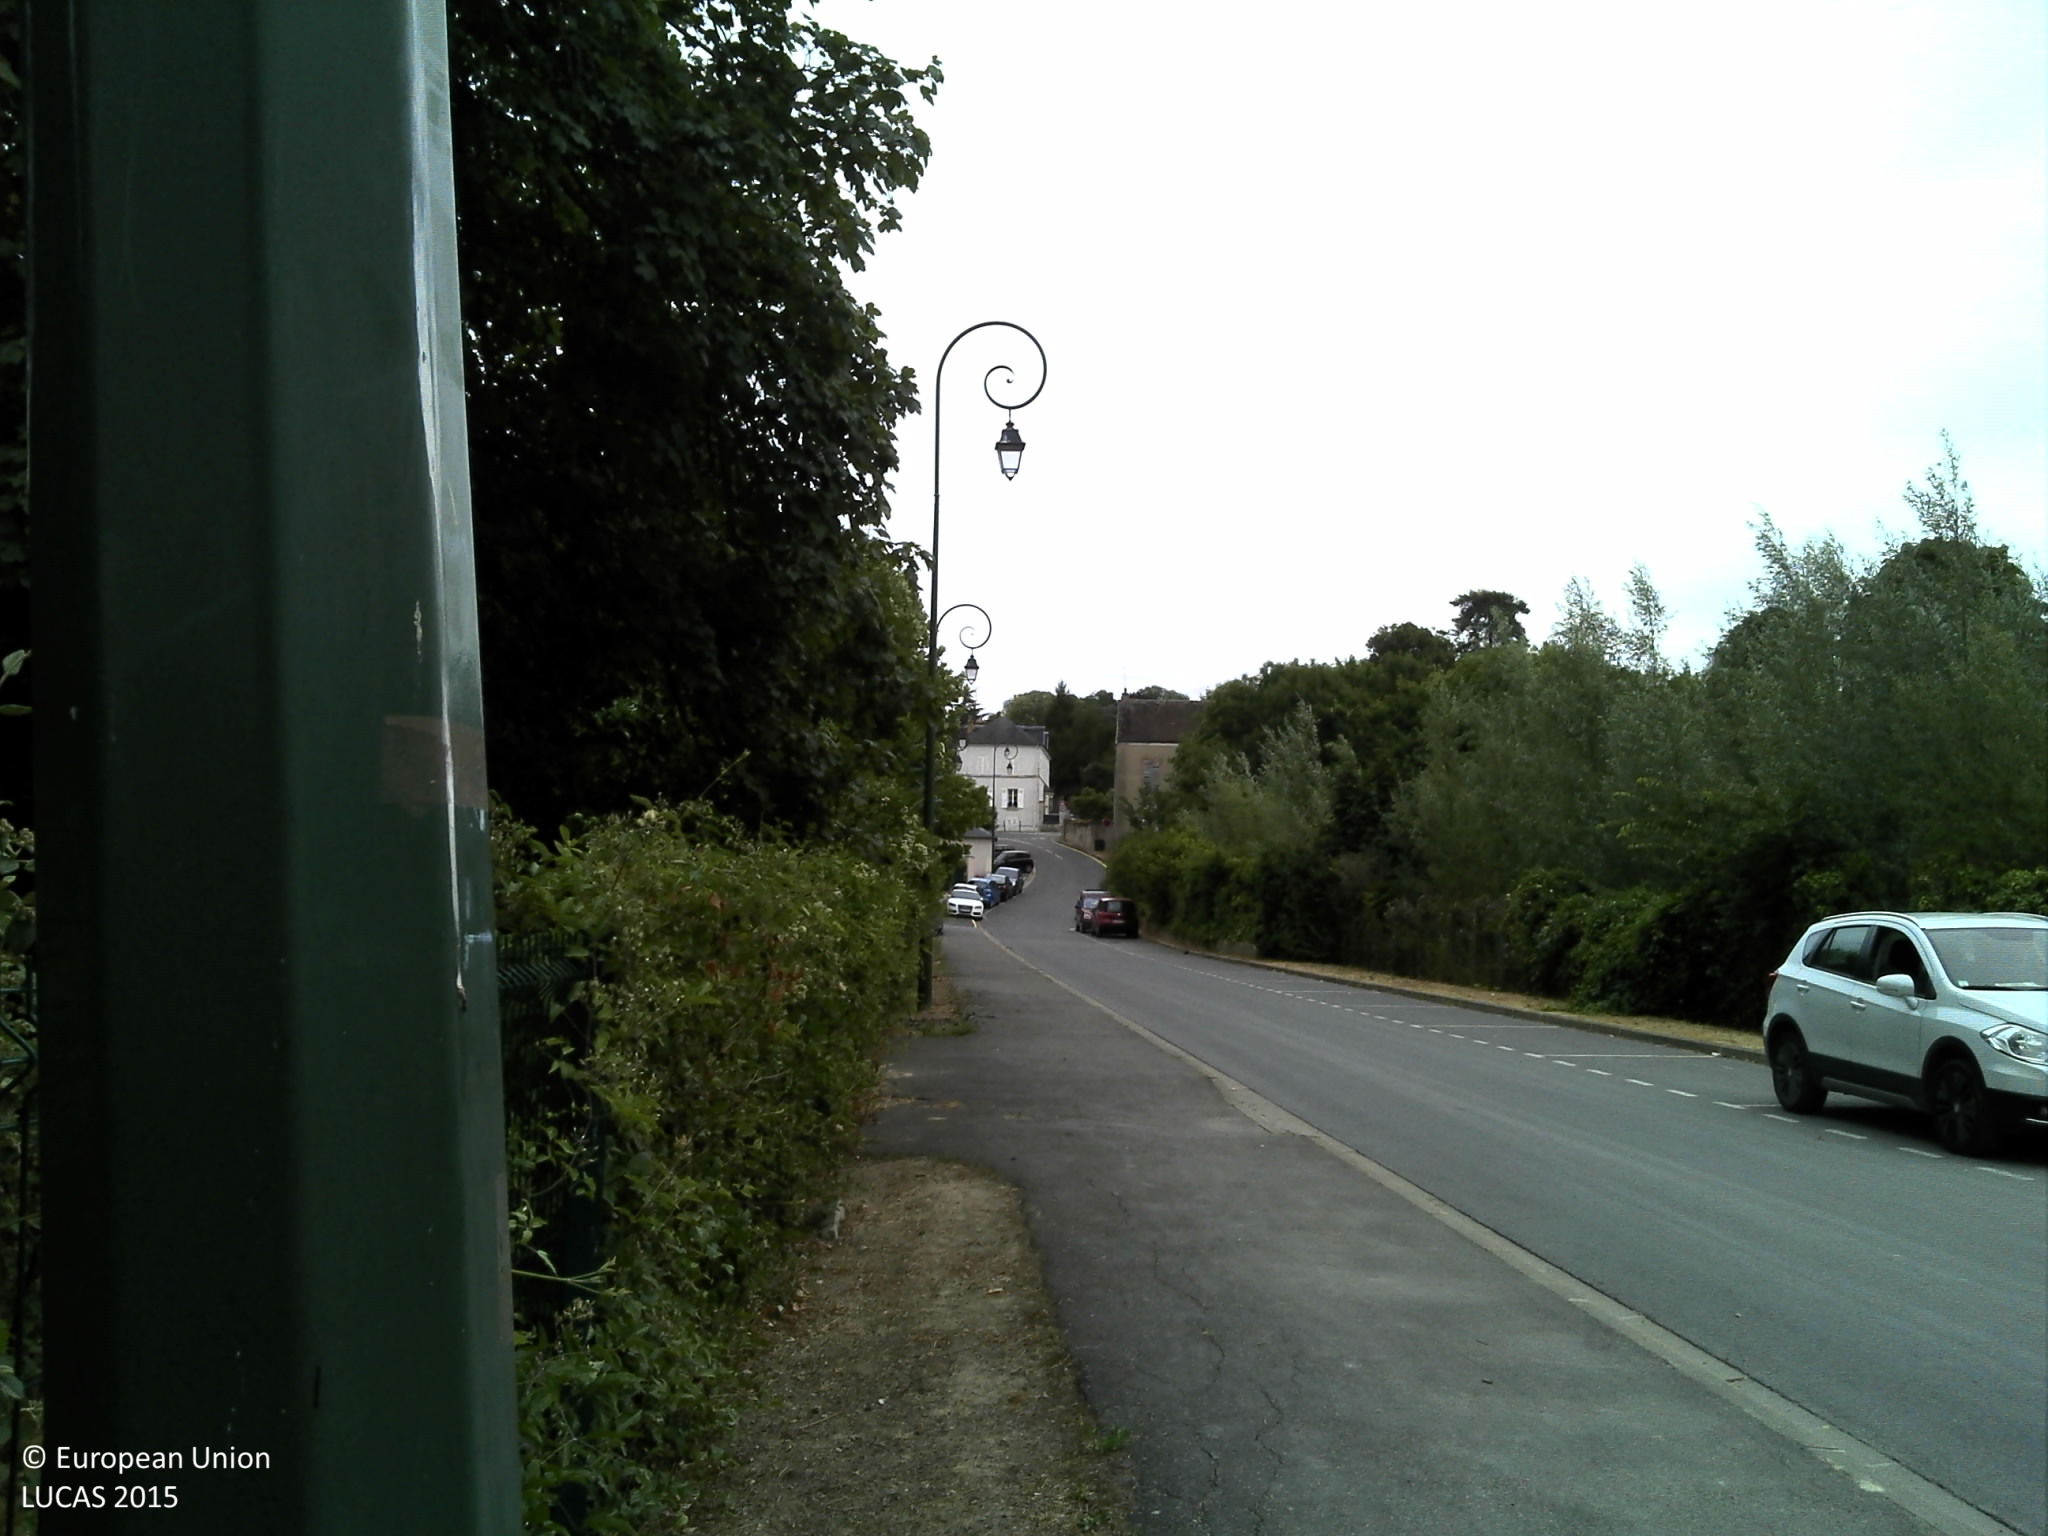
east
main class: Woodland
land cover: Broadleaved woodland
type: floodplain forest
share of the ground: > 75 %
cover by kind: broadleaved forest trees 70 %, herbaceous plants 30 %
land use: Amenities, museums, leisure
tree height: > 5 m
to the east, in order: Broadleaved woodland; Fences; Paved roads, cycling and walking lanes; Fences; Shrubland with sparse tree cover; Artificial constructions in urban areas
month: July
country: FR
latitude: 48.5996
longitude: 2.4903
